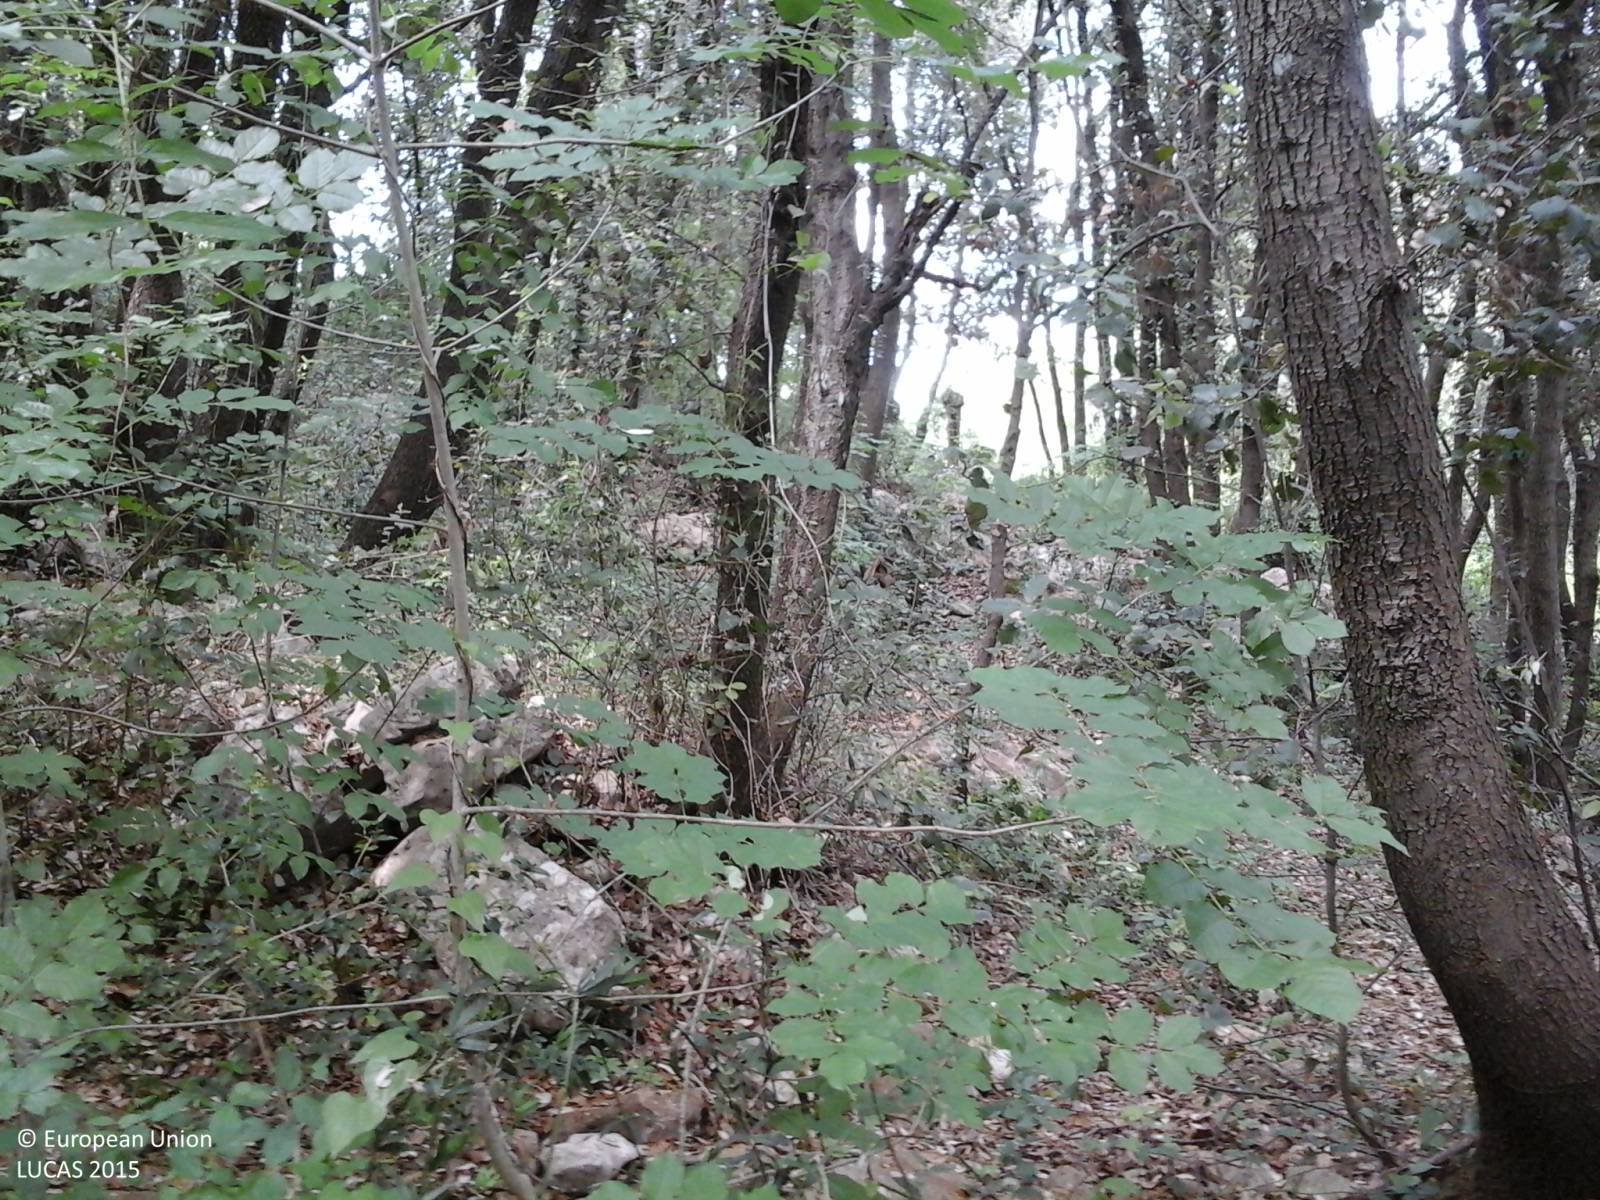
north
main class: Woodland
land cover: Broadleaved woodland
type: thermophilous deciduous forest
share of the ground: > 75 %
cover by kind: broadleaved forest trees 100 %
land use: Forestry
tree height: > 5 m
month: May
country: IT
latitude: 41.2221
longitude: 14.3372
